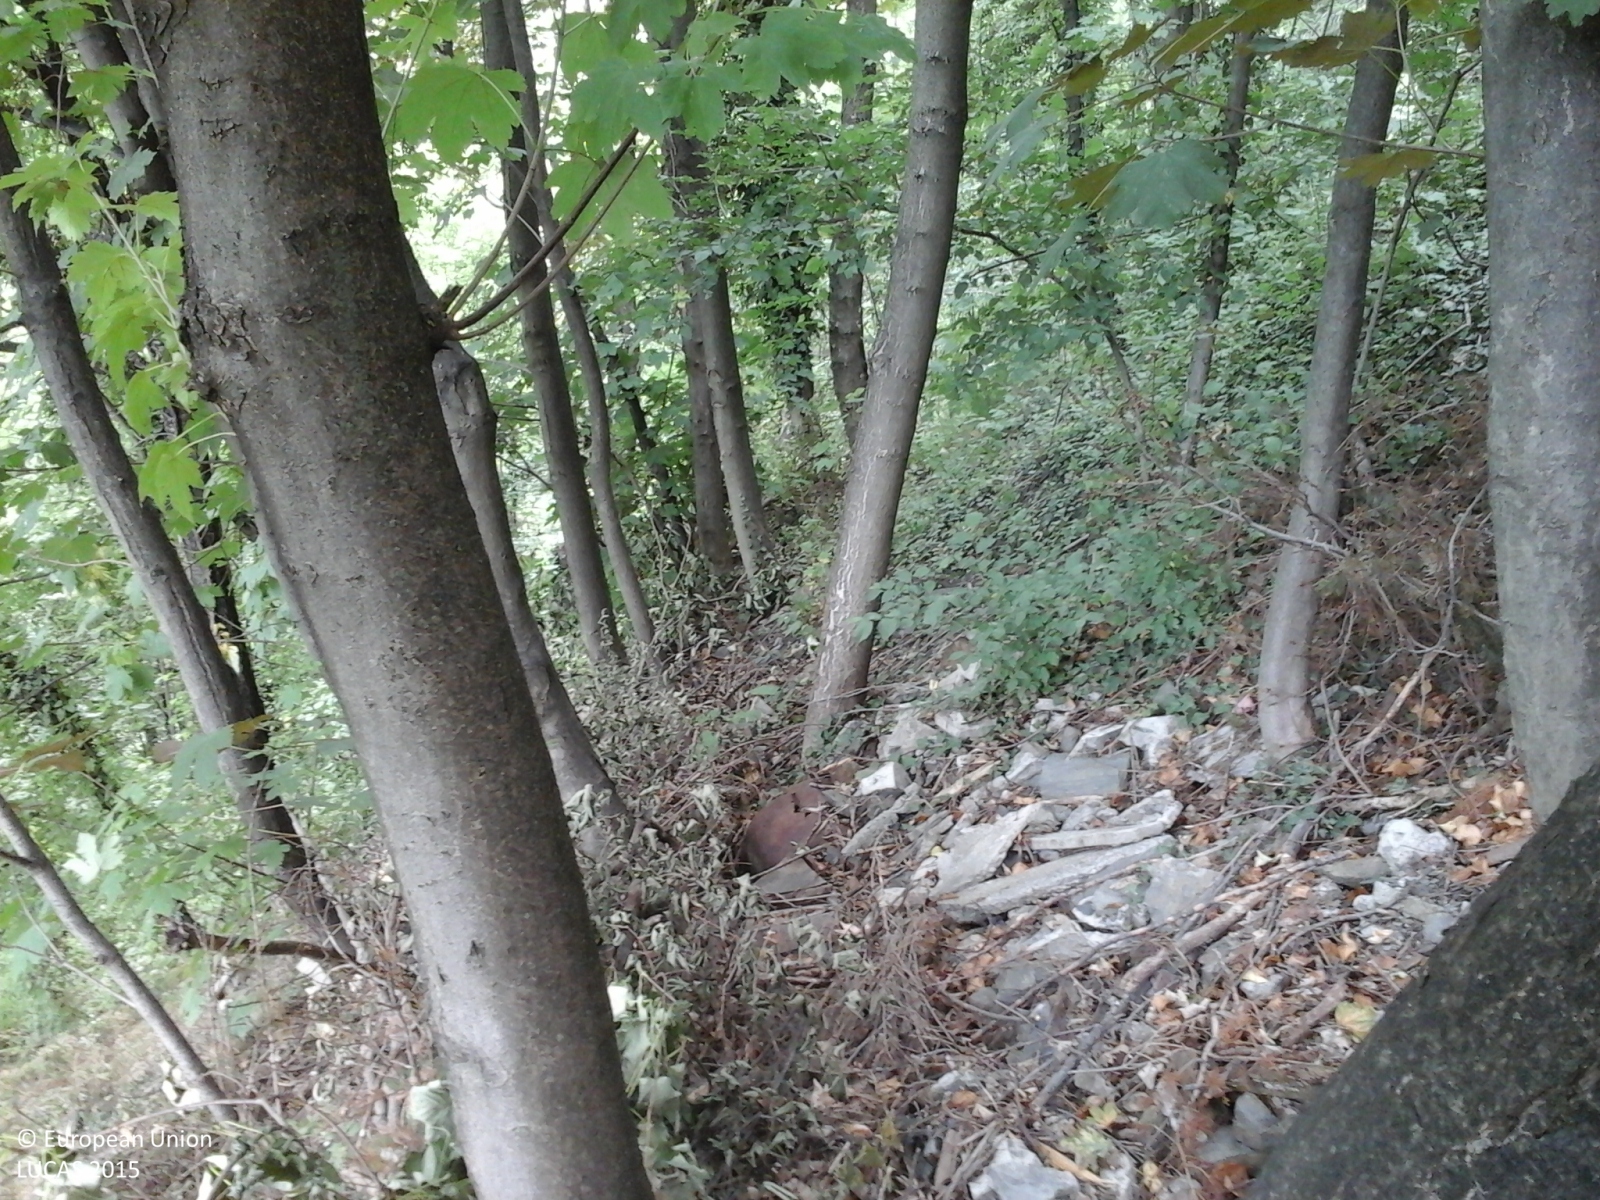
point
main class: Woodland
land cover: Broadleaved woodland
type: thermophilous deciduous forest
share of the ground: > 75 %
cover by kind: broadleaved forest trees 100 %
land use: Forestry
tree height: > 5 m
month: July
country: IT
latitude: 44.9451
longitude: 7.2293
